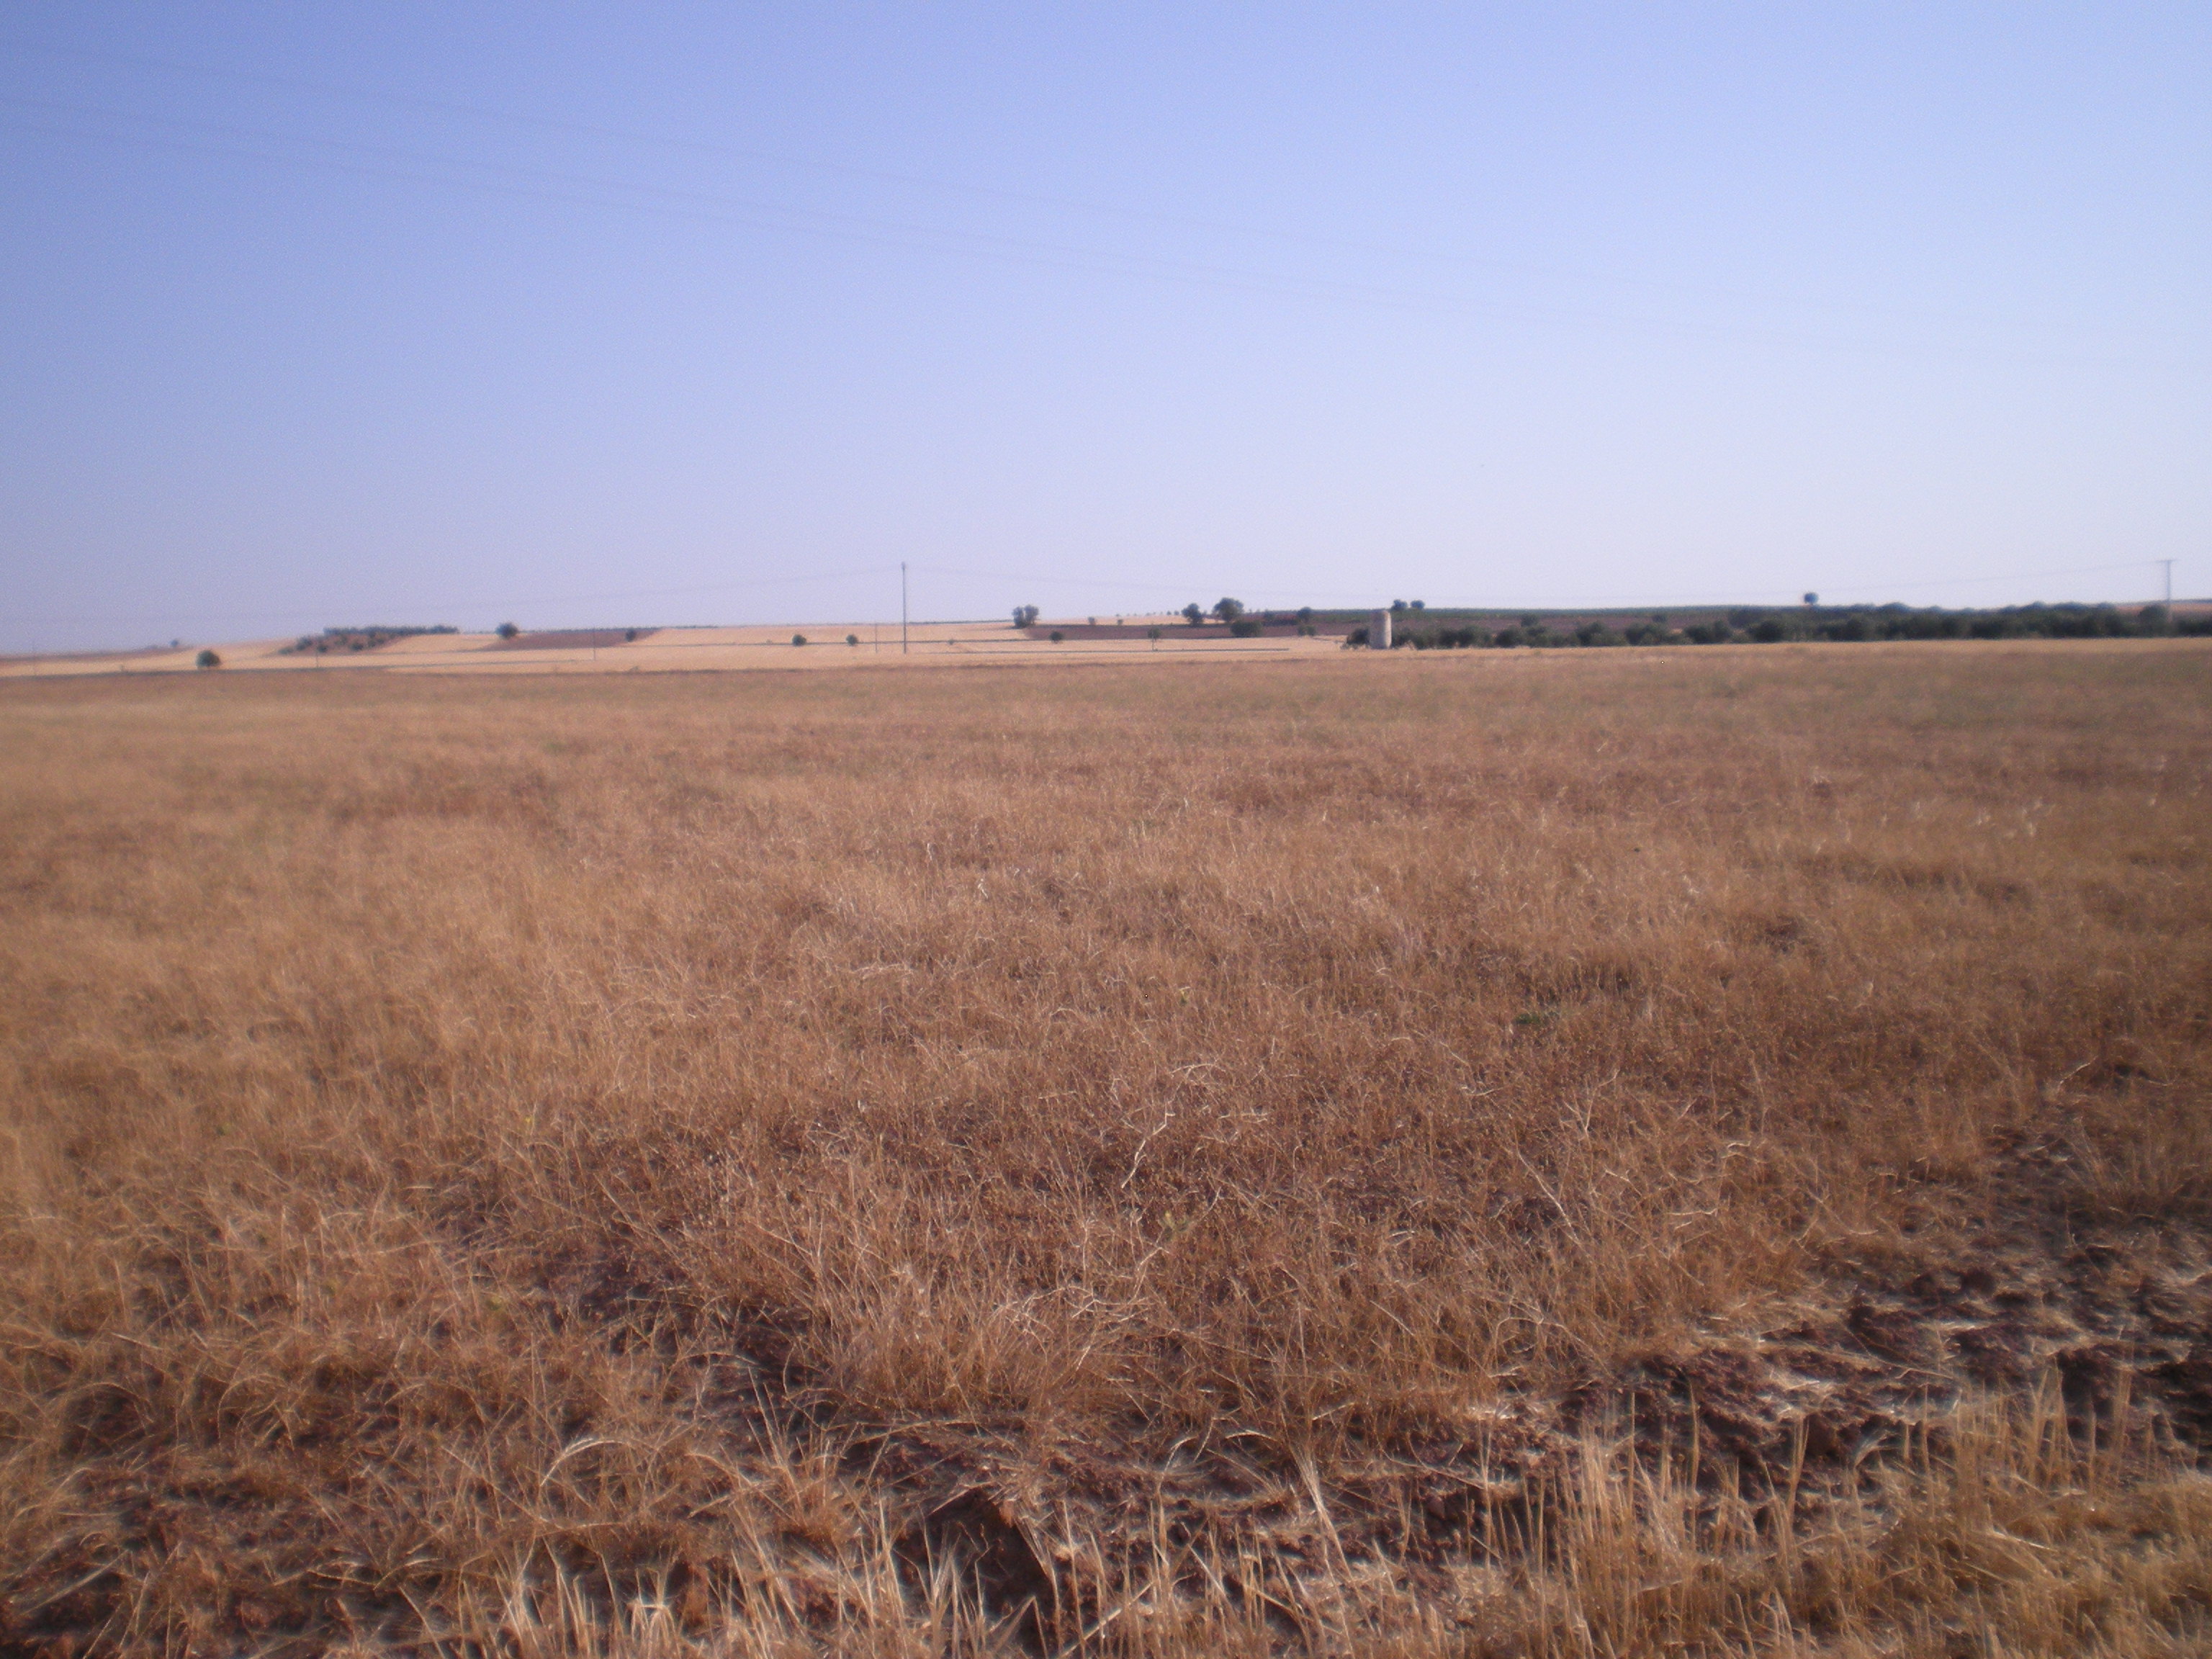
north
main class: Cropland
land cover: Barley
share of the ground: < 10 %
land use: Agriculture (excluding fallow land and kitchen gardens)
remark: Harvested field
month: July
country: ES
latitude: 39.4875
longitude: -3.2863
